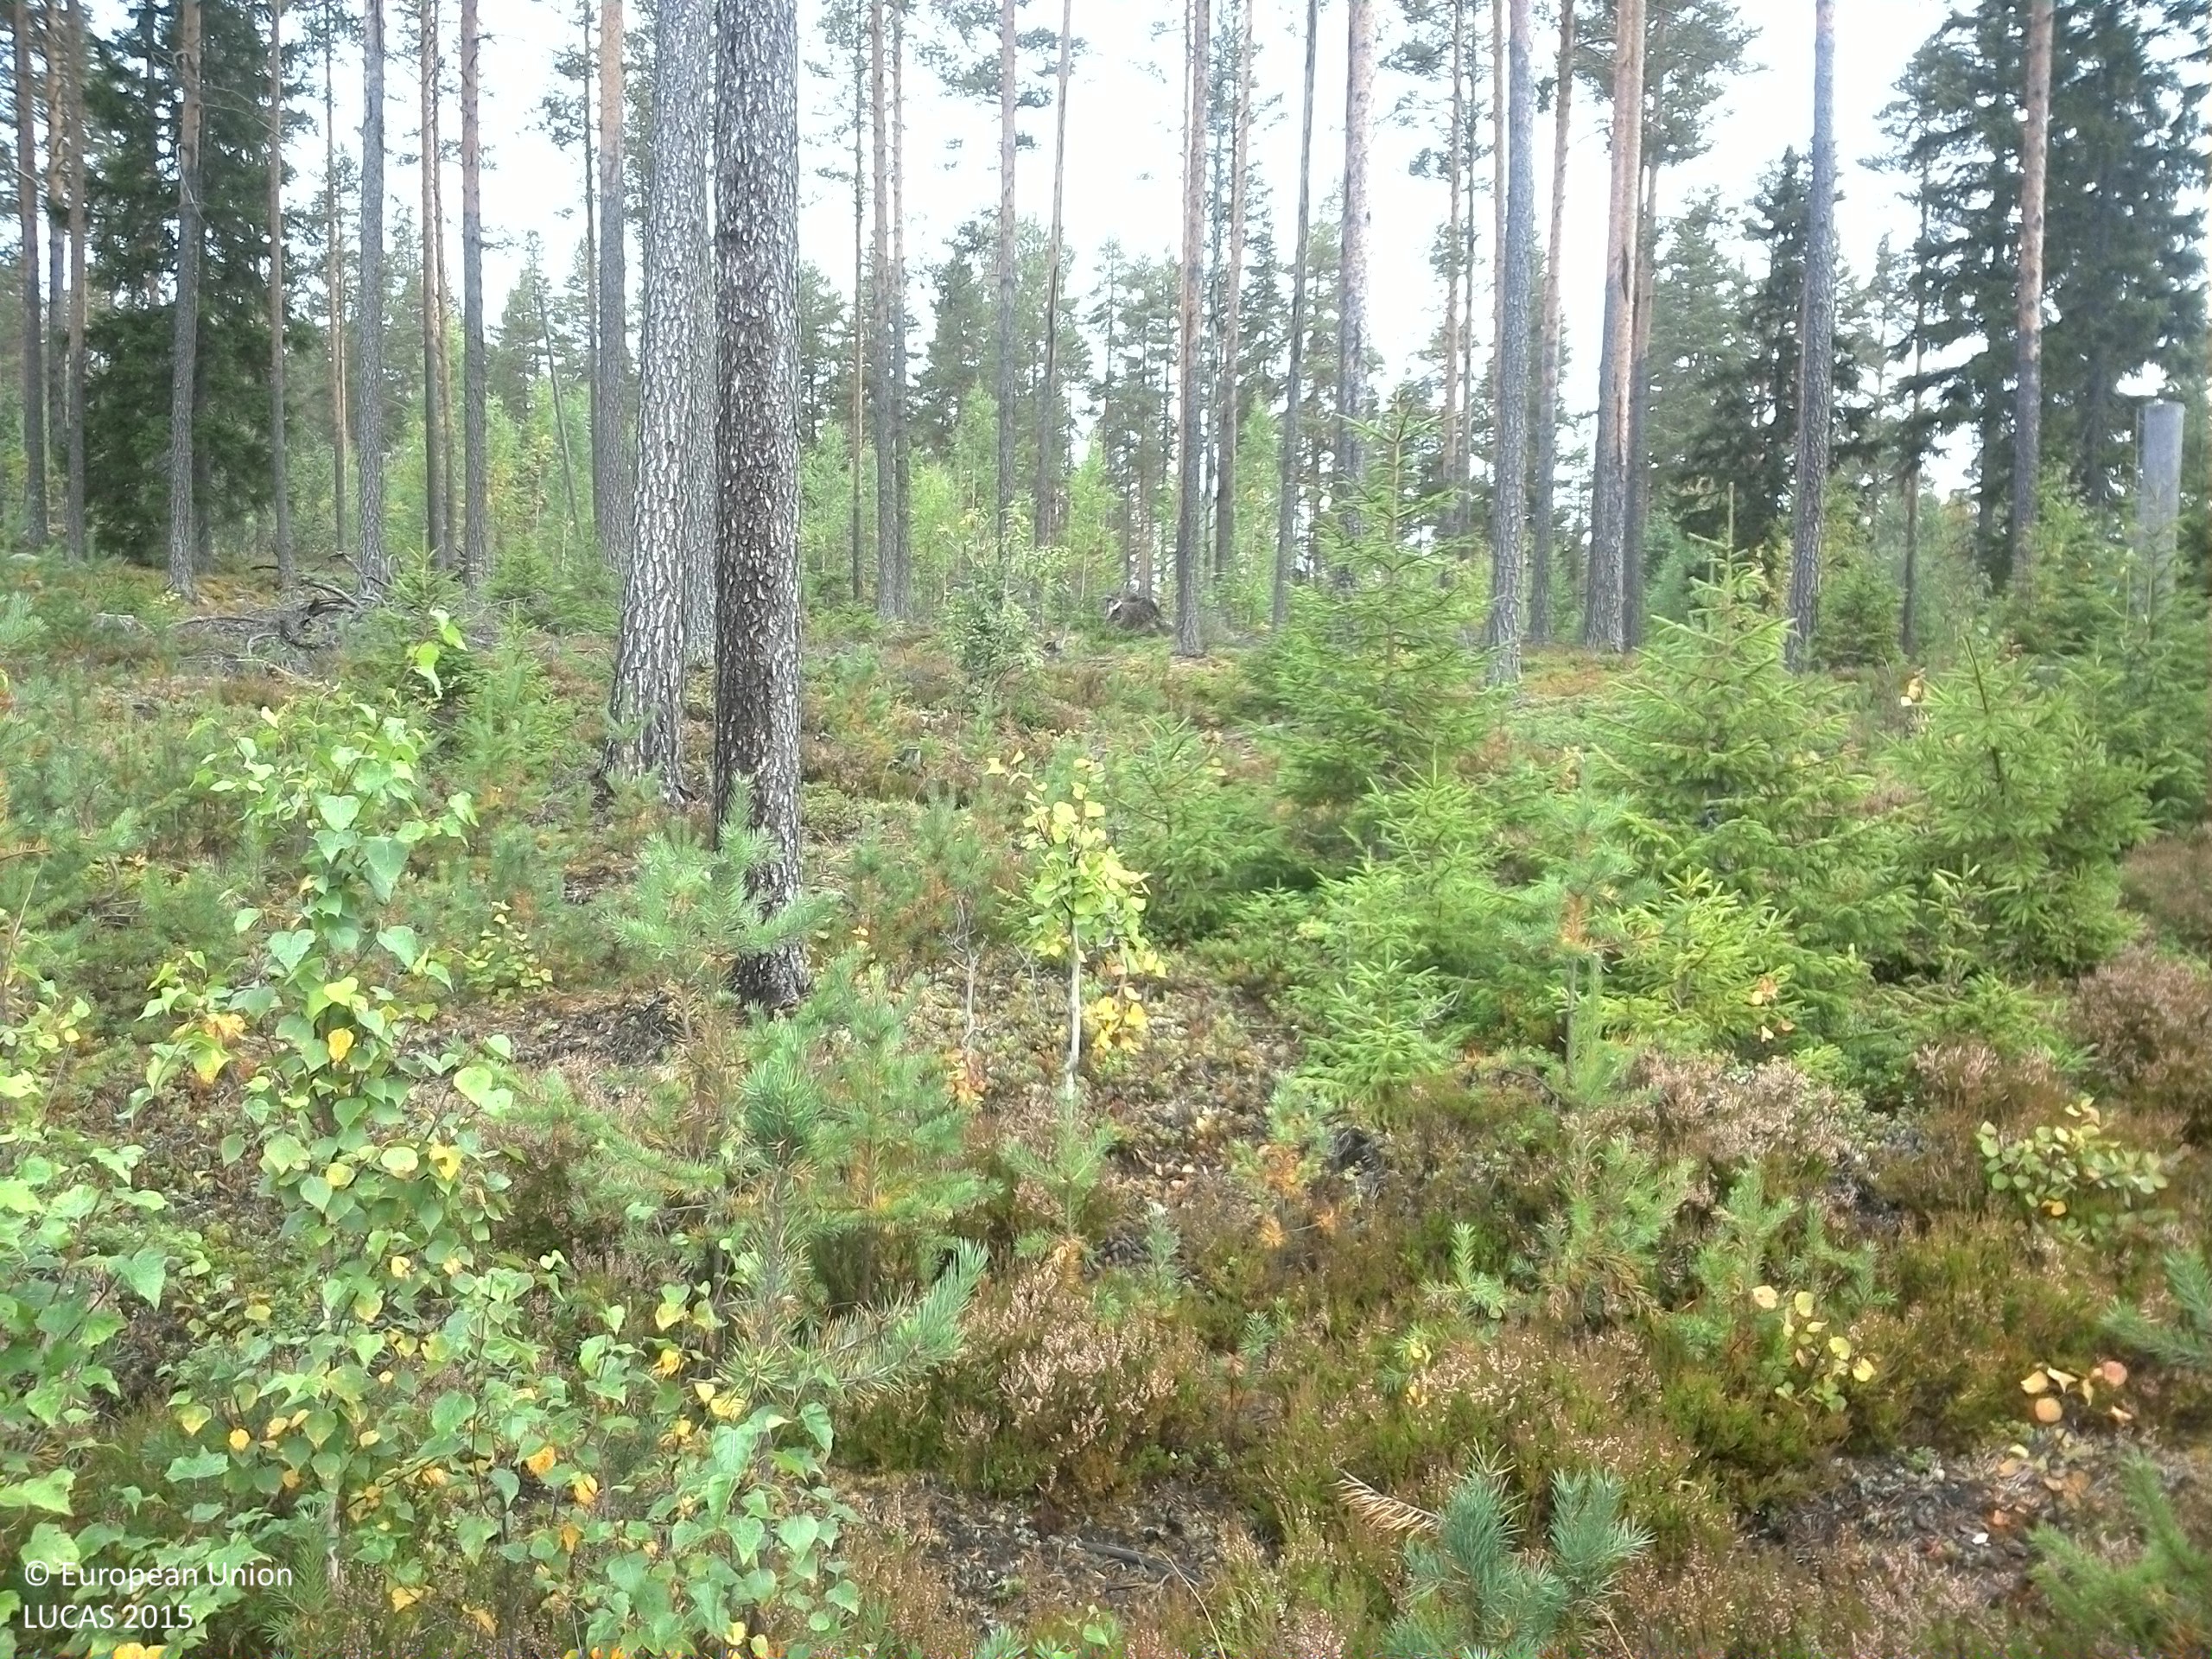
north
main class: Woodland
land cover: Other mixed woodland
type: boreal forest
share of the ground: 50 - 75 %
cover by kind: coniferous forest trees 30 %, broadleaved forest trees 30 %, shrubs 20 %, herbaceous plants 10 %, lichens and mosses 10 %
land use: Forestry
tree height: < 5 m
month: September
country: SE
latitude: 61.6383
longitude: 15.1730
